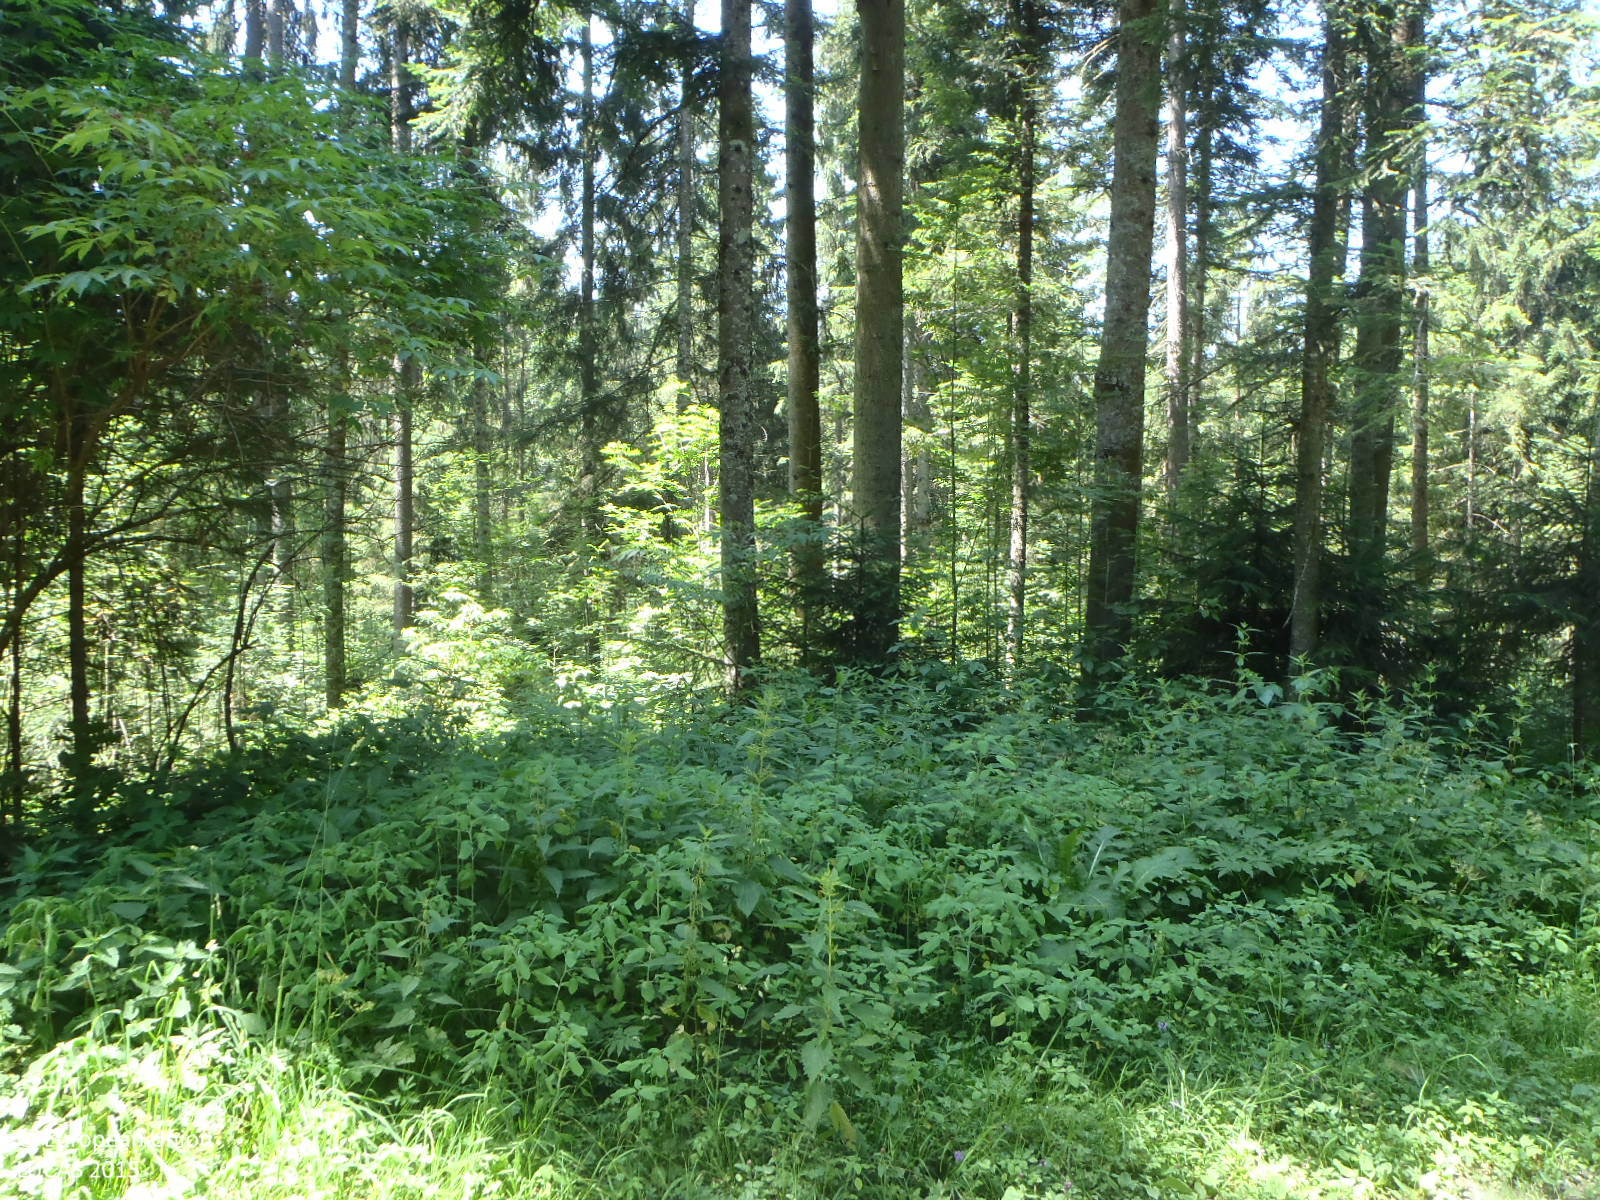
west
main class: Woodland
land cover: Other coniferous woodland
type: alpine coniferous forest
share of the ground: > 75 %
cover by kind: coniferous forest trees 75 %, broadleaved forest trees 25 %
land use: Forestry
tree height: > 5 m
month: July
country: AT
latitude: 47.4778
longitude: 12.3736
